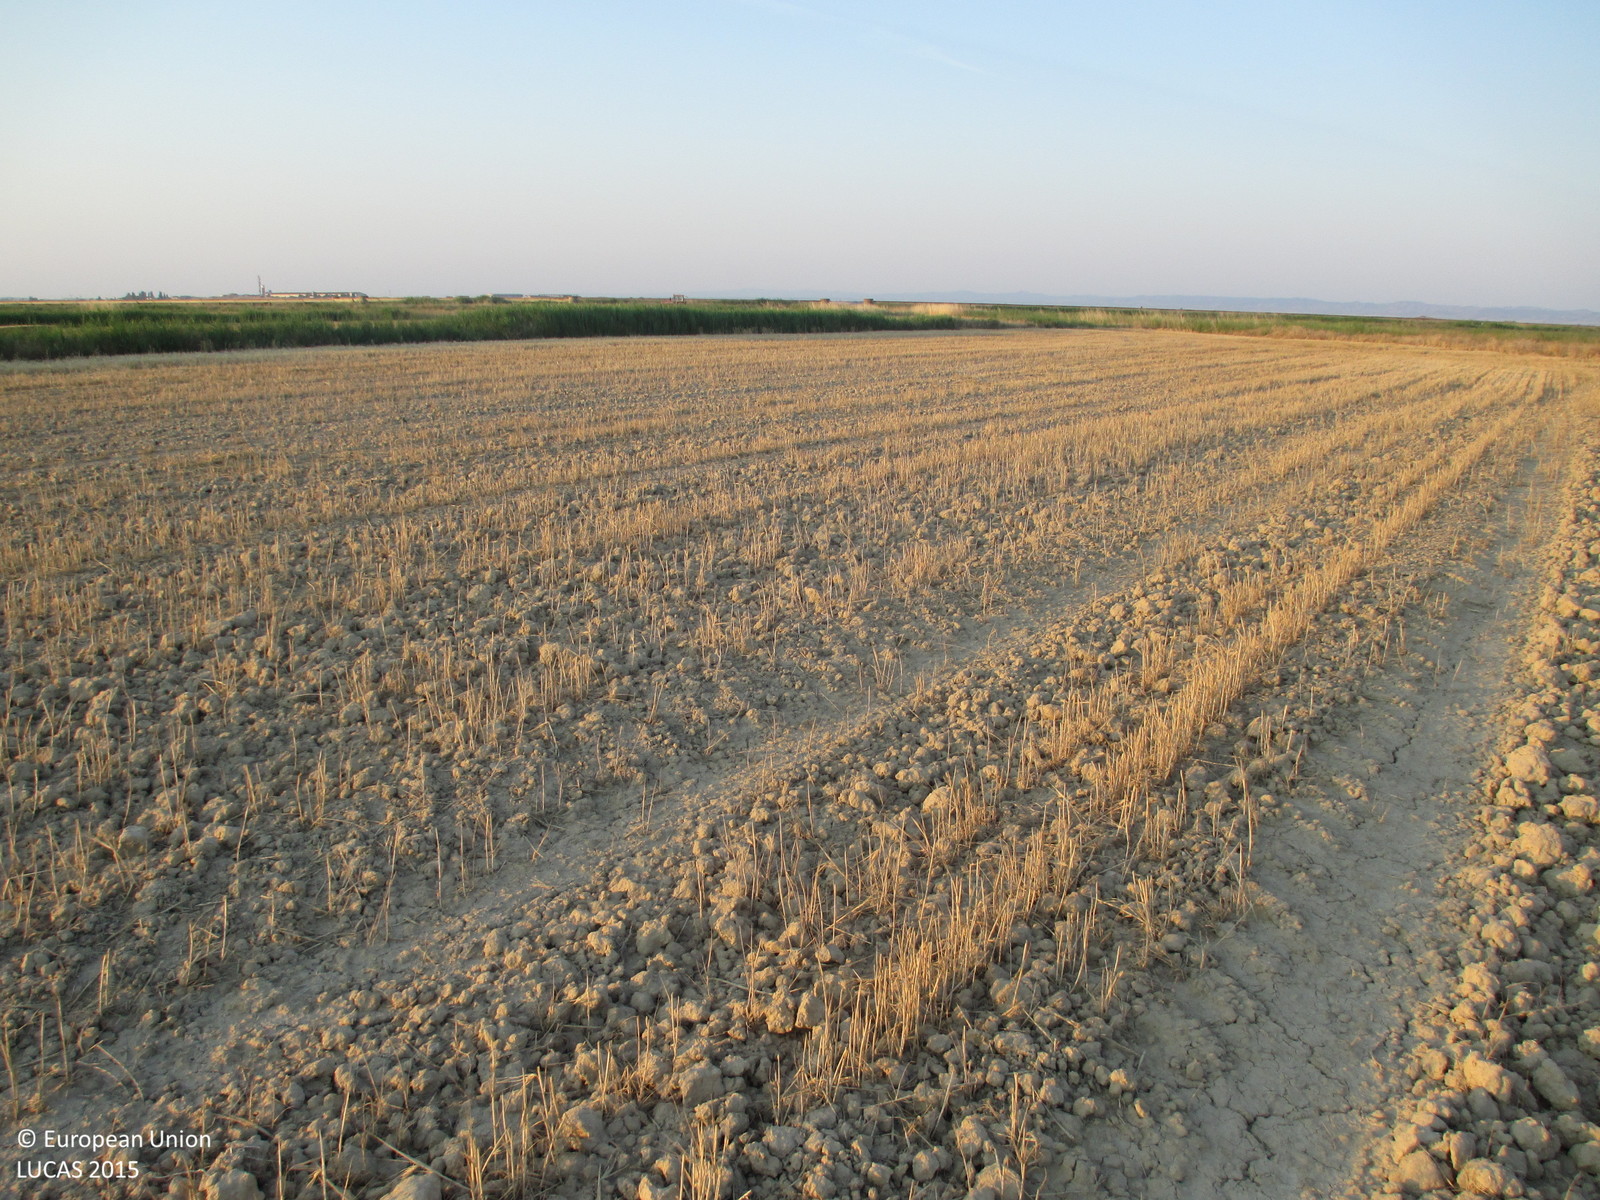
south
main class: Cropland
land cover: Barley
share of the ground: < 10 %
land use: Agriculture (excluding fallow land and kitchen gardens)
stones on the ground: < 10 %
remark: Harvested field
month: June
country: ES
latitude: 42.0395
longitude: -0.4473
